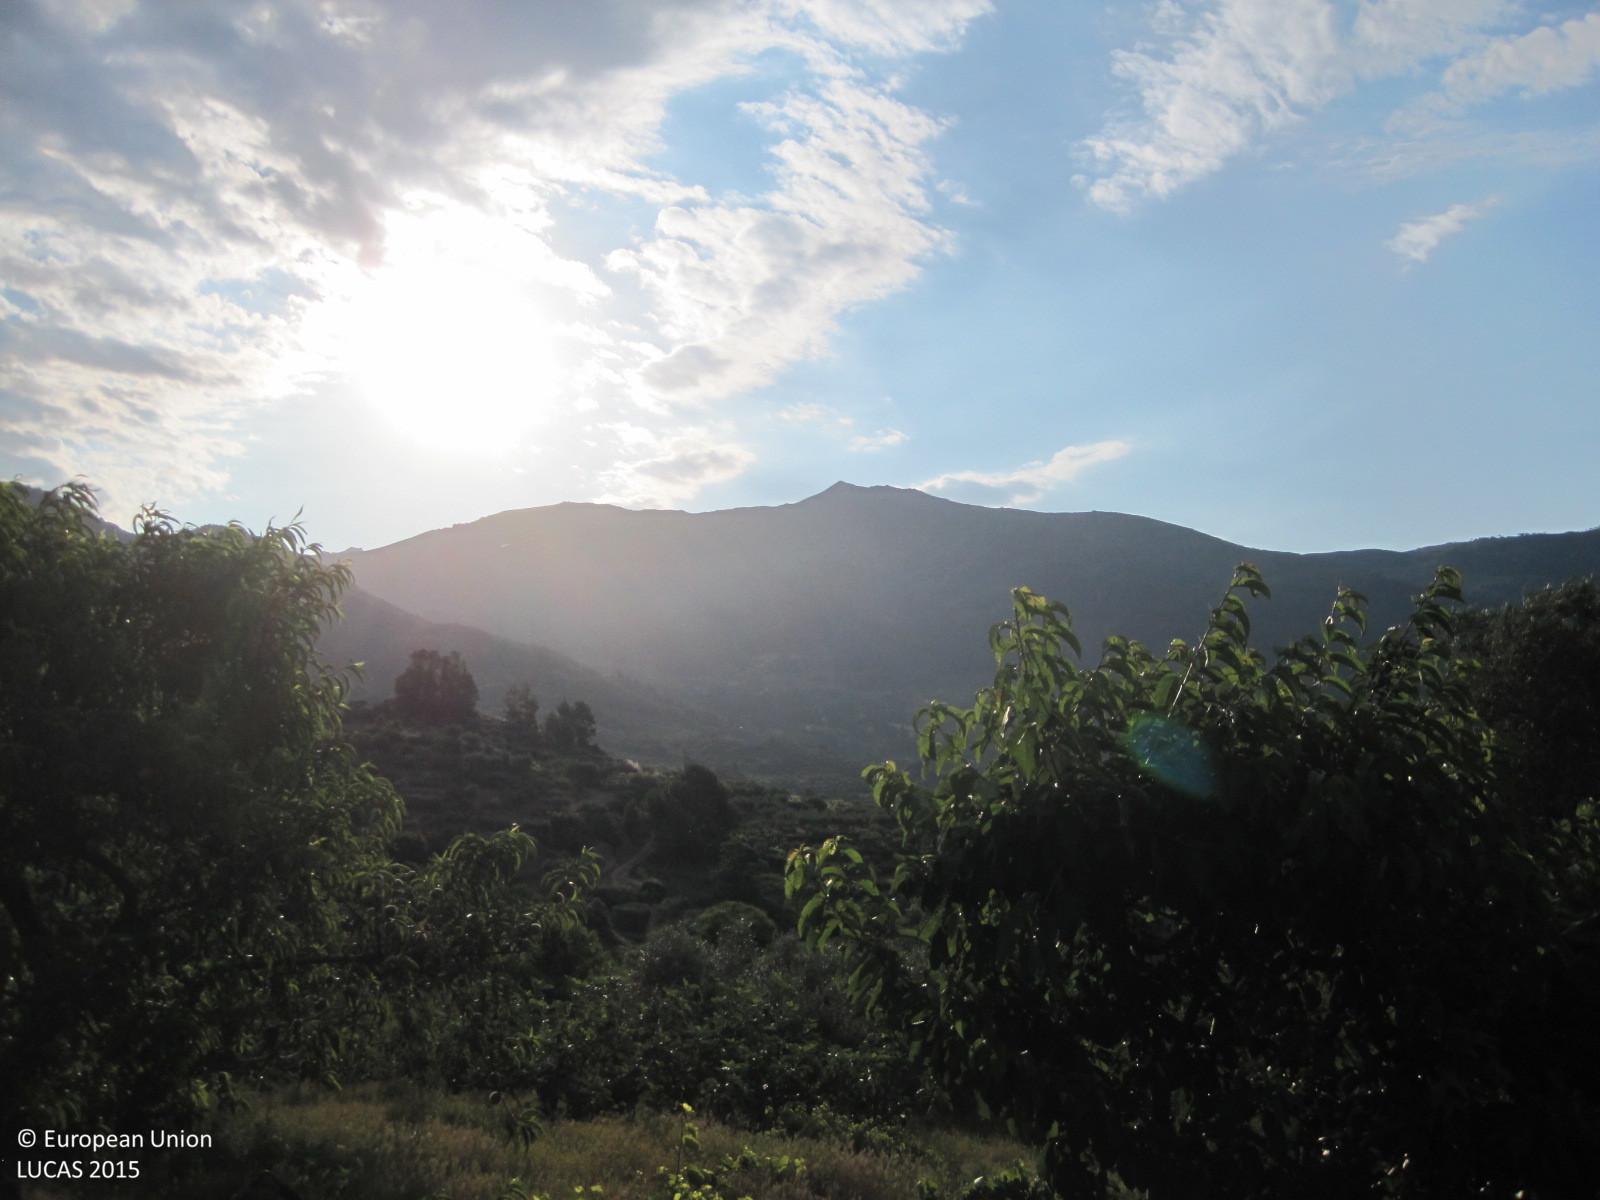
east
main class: Cropland
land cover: Vineyards
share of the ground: 25 - 50 %
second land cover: Nuts trees
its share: 25 - 50 %
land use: Agriculture (excluding fallow land and kitchen gardens)
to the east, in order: Vineyards; Nuts trees; Grass margins; Tracks; Grass margins; Olive groves; Dry stone walls; Olive groves; Grass margins; Tracks; Grass margins; Olive groves; Other fruit trees and berries; Dry stone walls; Shrubland with sparse tree cover
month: June
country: ES
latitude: 40.2814
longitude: -5.0044
